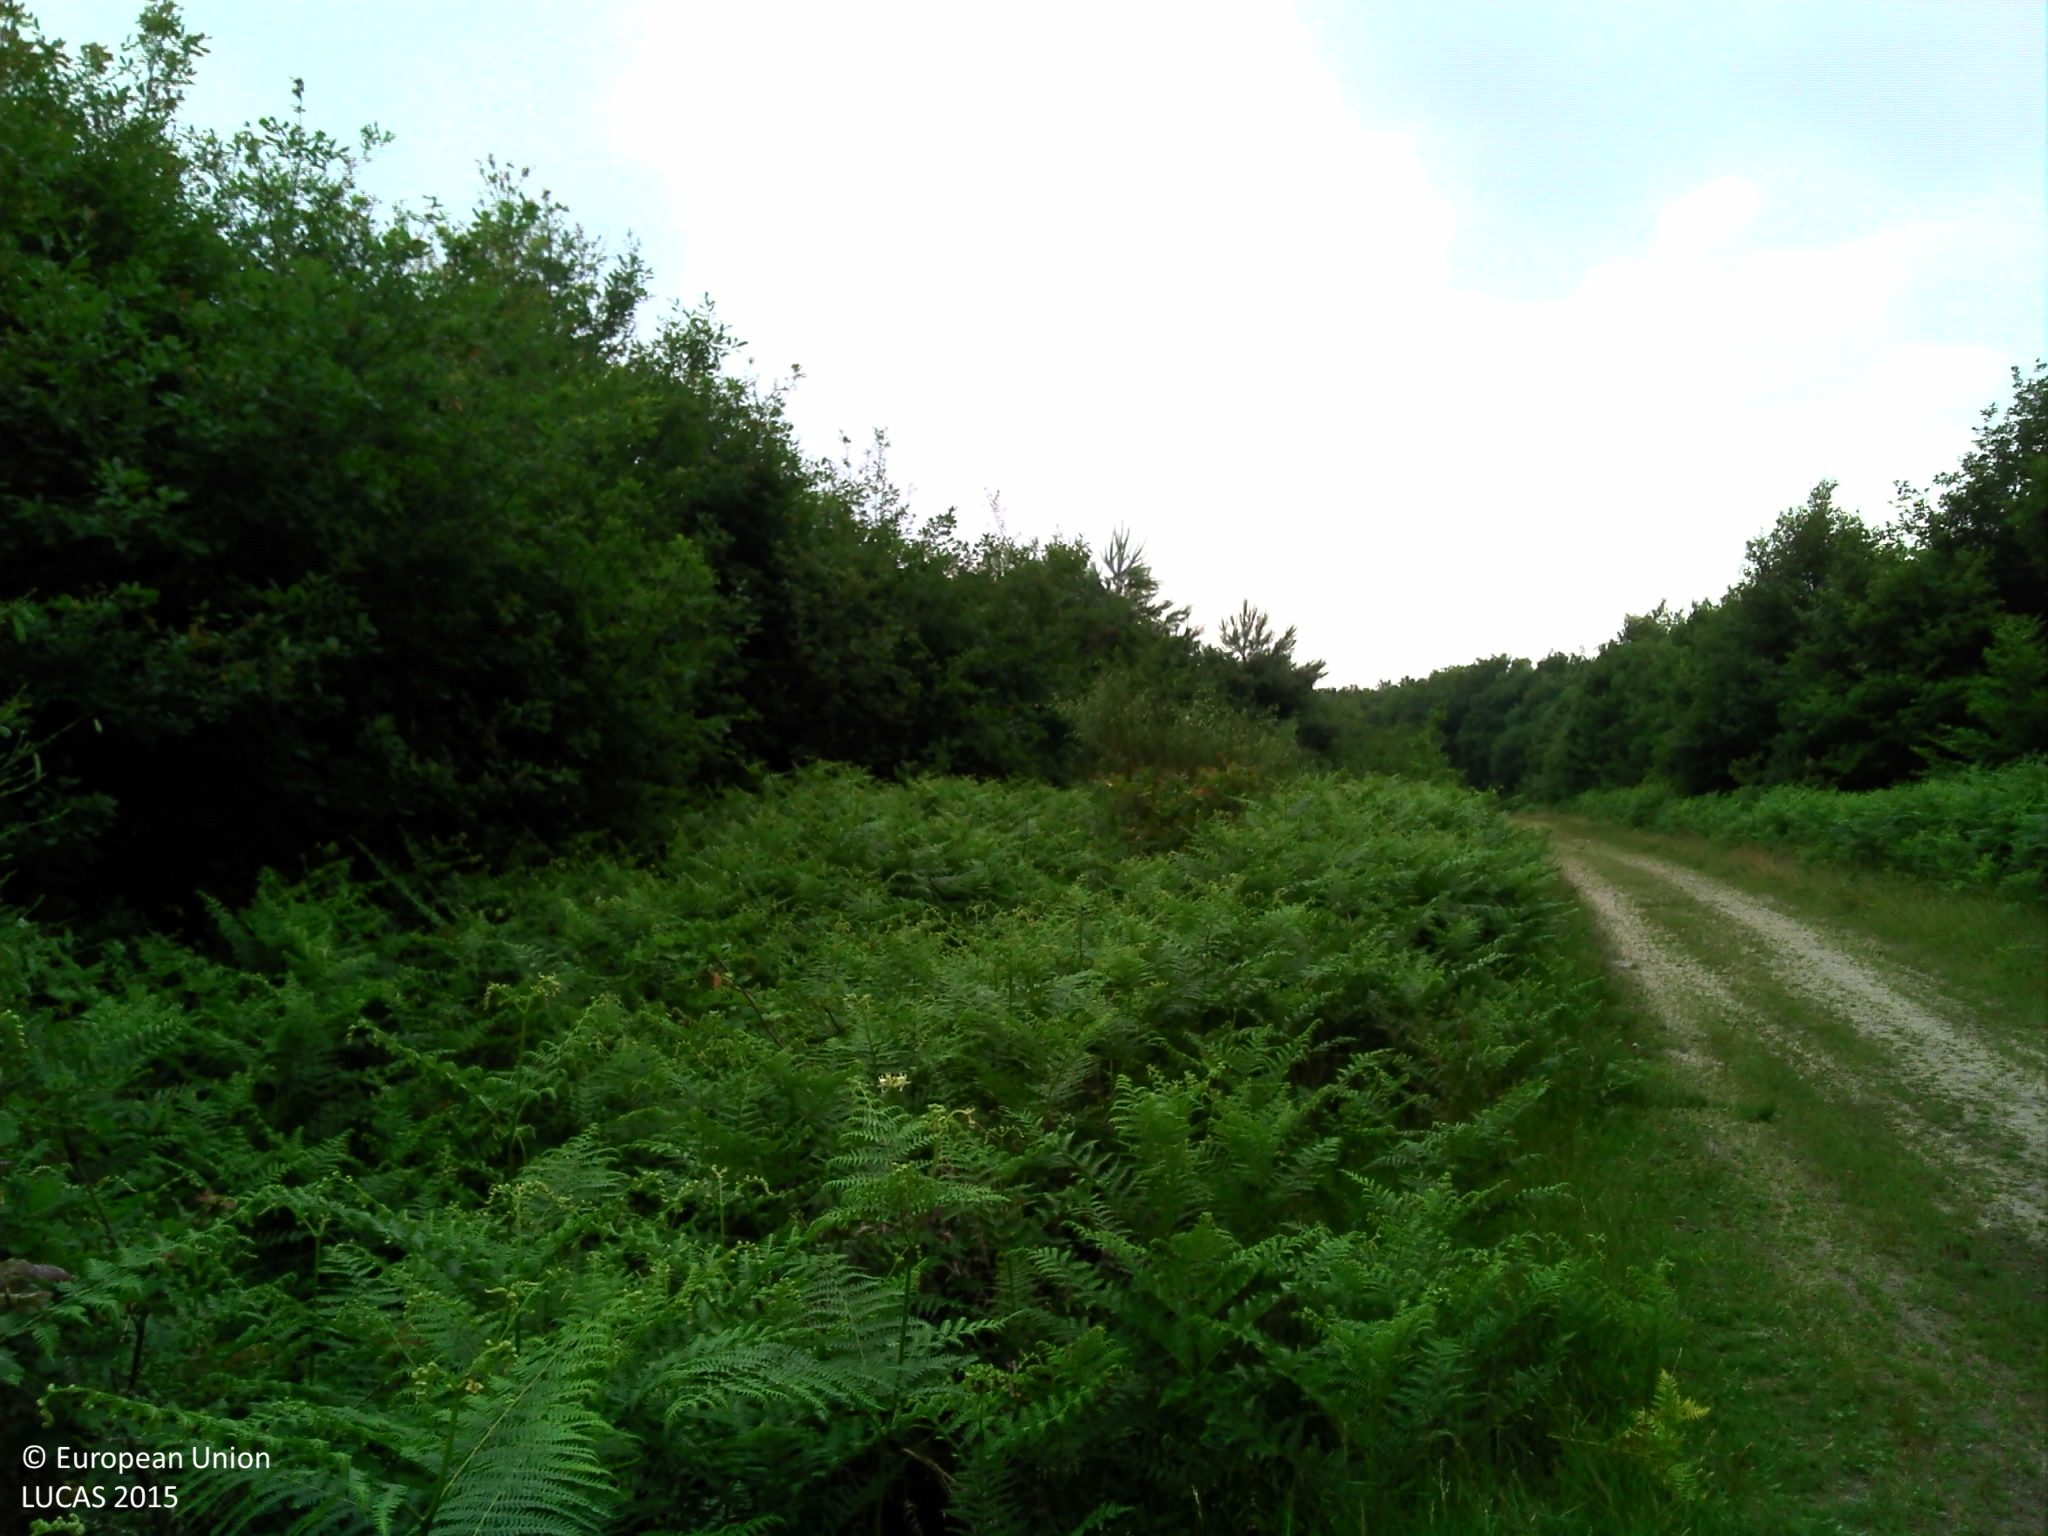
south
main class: Shrubland
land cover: Shrubland with sparse tree cover
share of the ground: > 75 %
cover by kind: shrubs 95 %, broadleaved forest trees 5 %
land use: Forestry
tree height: < 5 m
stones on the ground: < 10 %
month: June
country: FR
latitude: 46.6238
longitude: 2.6688
